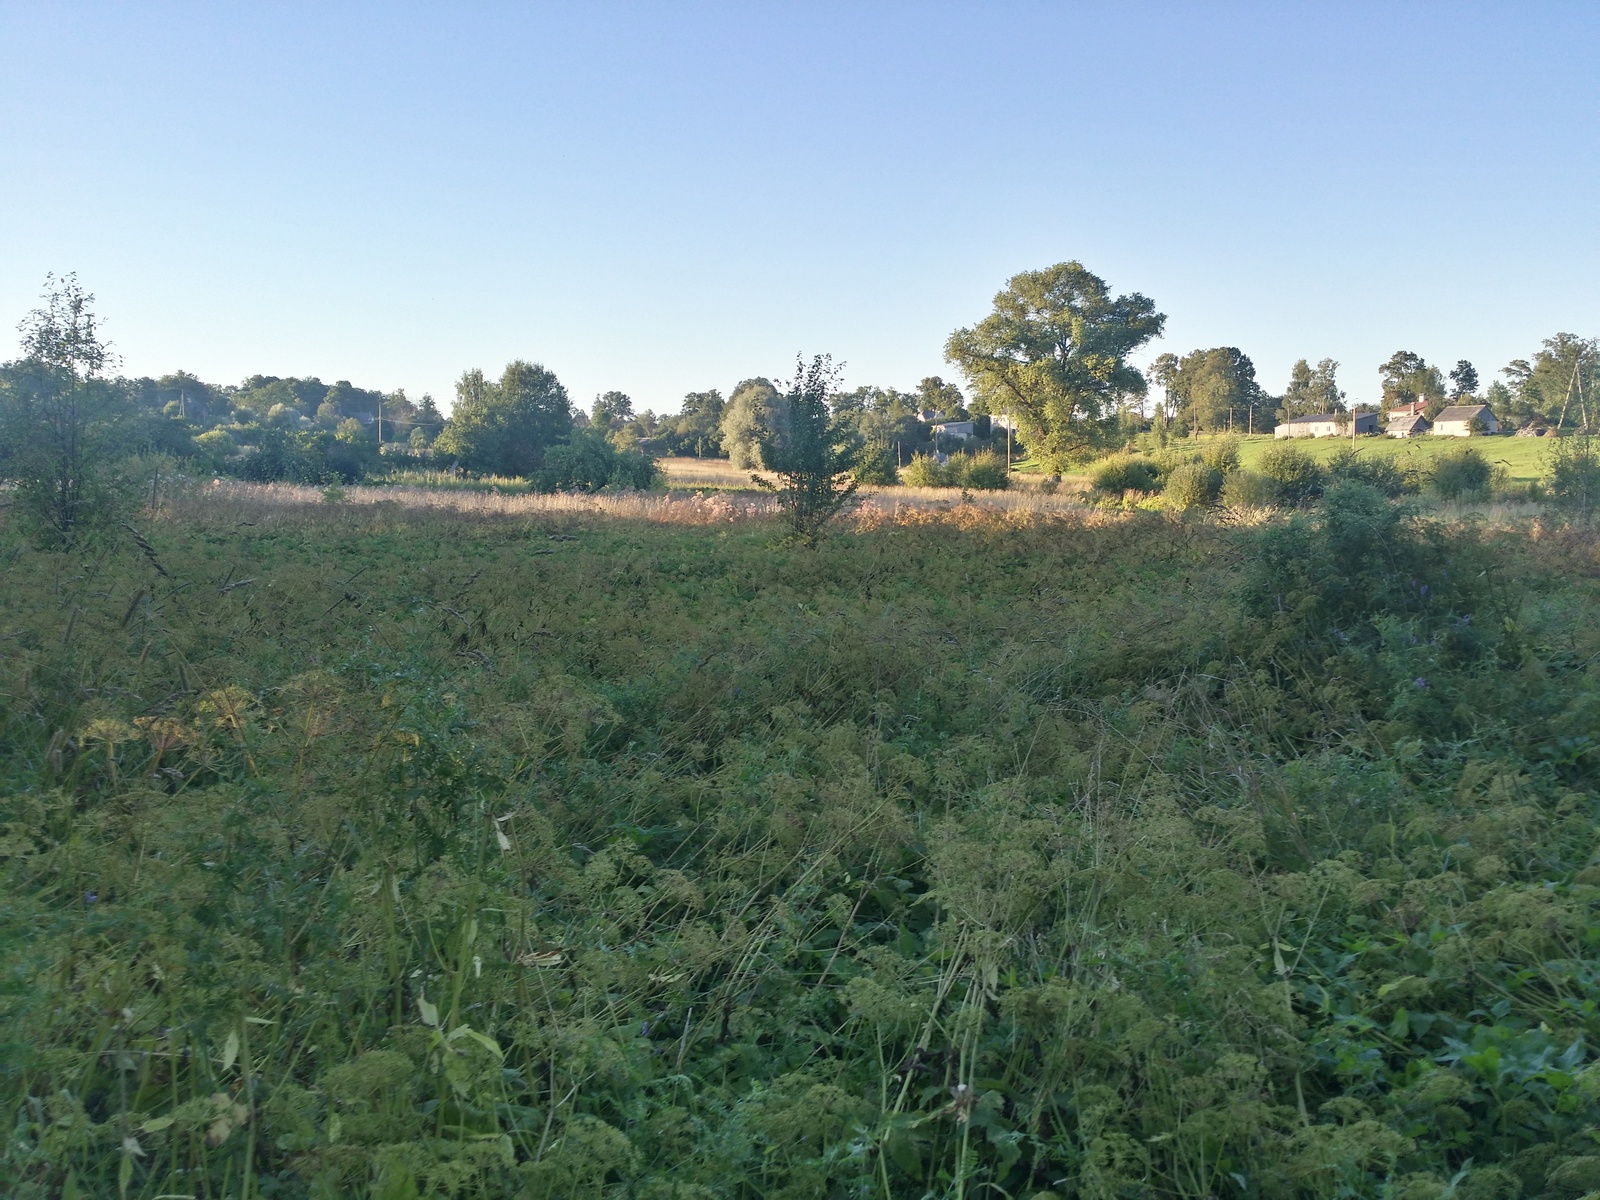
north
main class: Grassland
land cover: Spontaneously vegetated surfaces
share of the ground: > 75 %
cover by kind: herbaceous plants 95 %, shrubs 5 %
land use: Semi-natural and natural areas not in use
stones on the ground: < 10 %
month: August
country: LV
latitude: 57.1543
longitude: 26.7663
